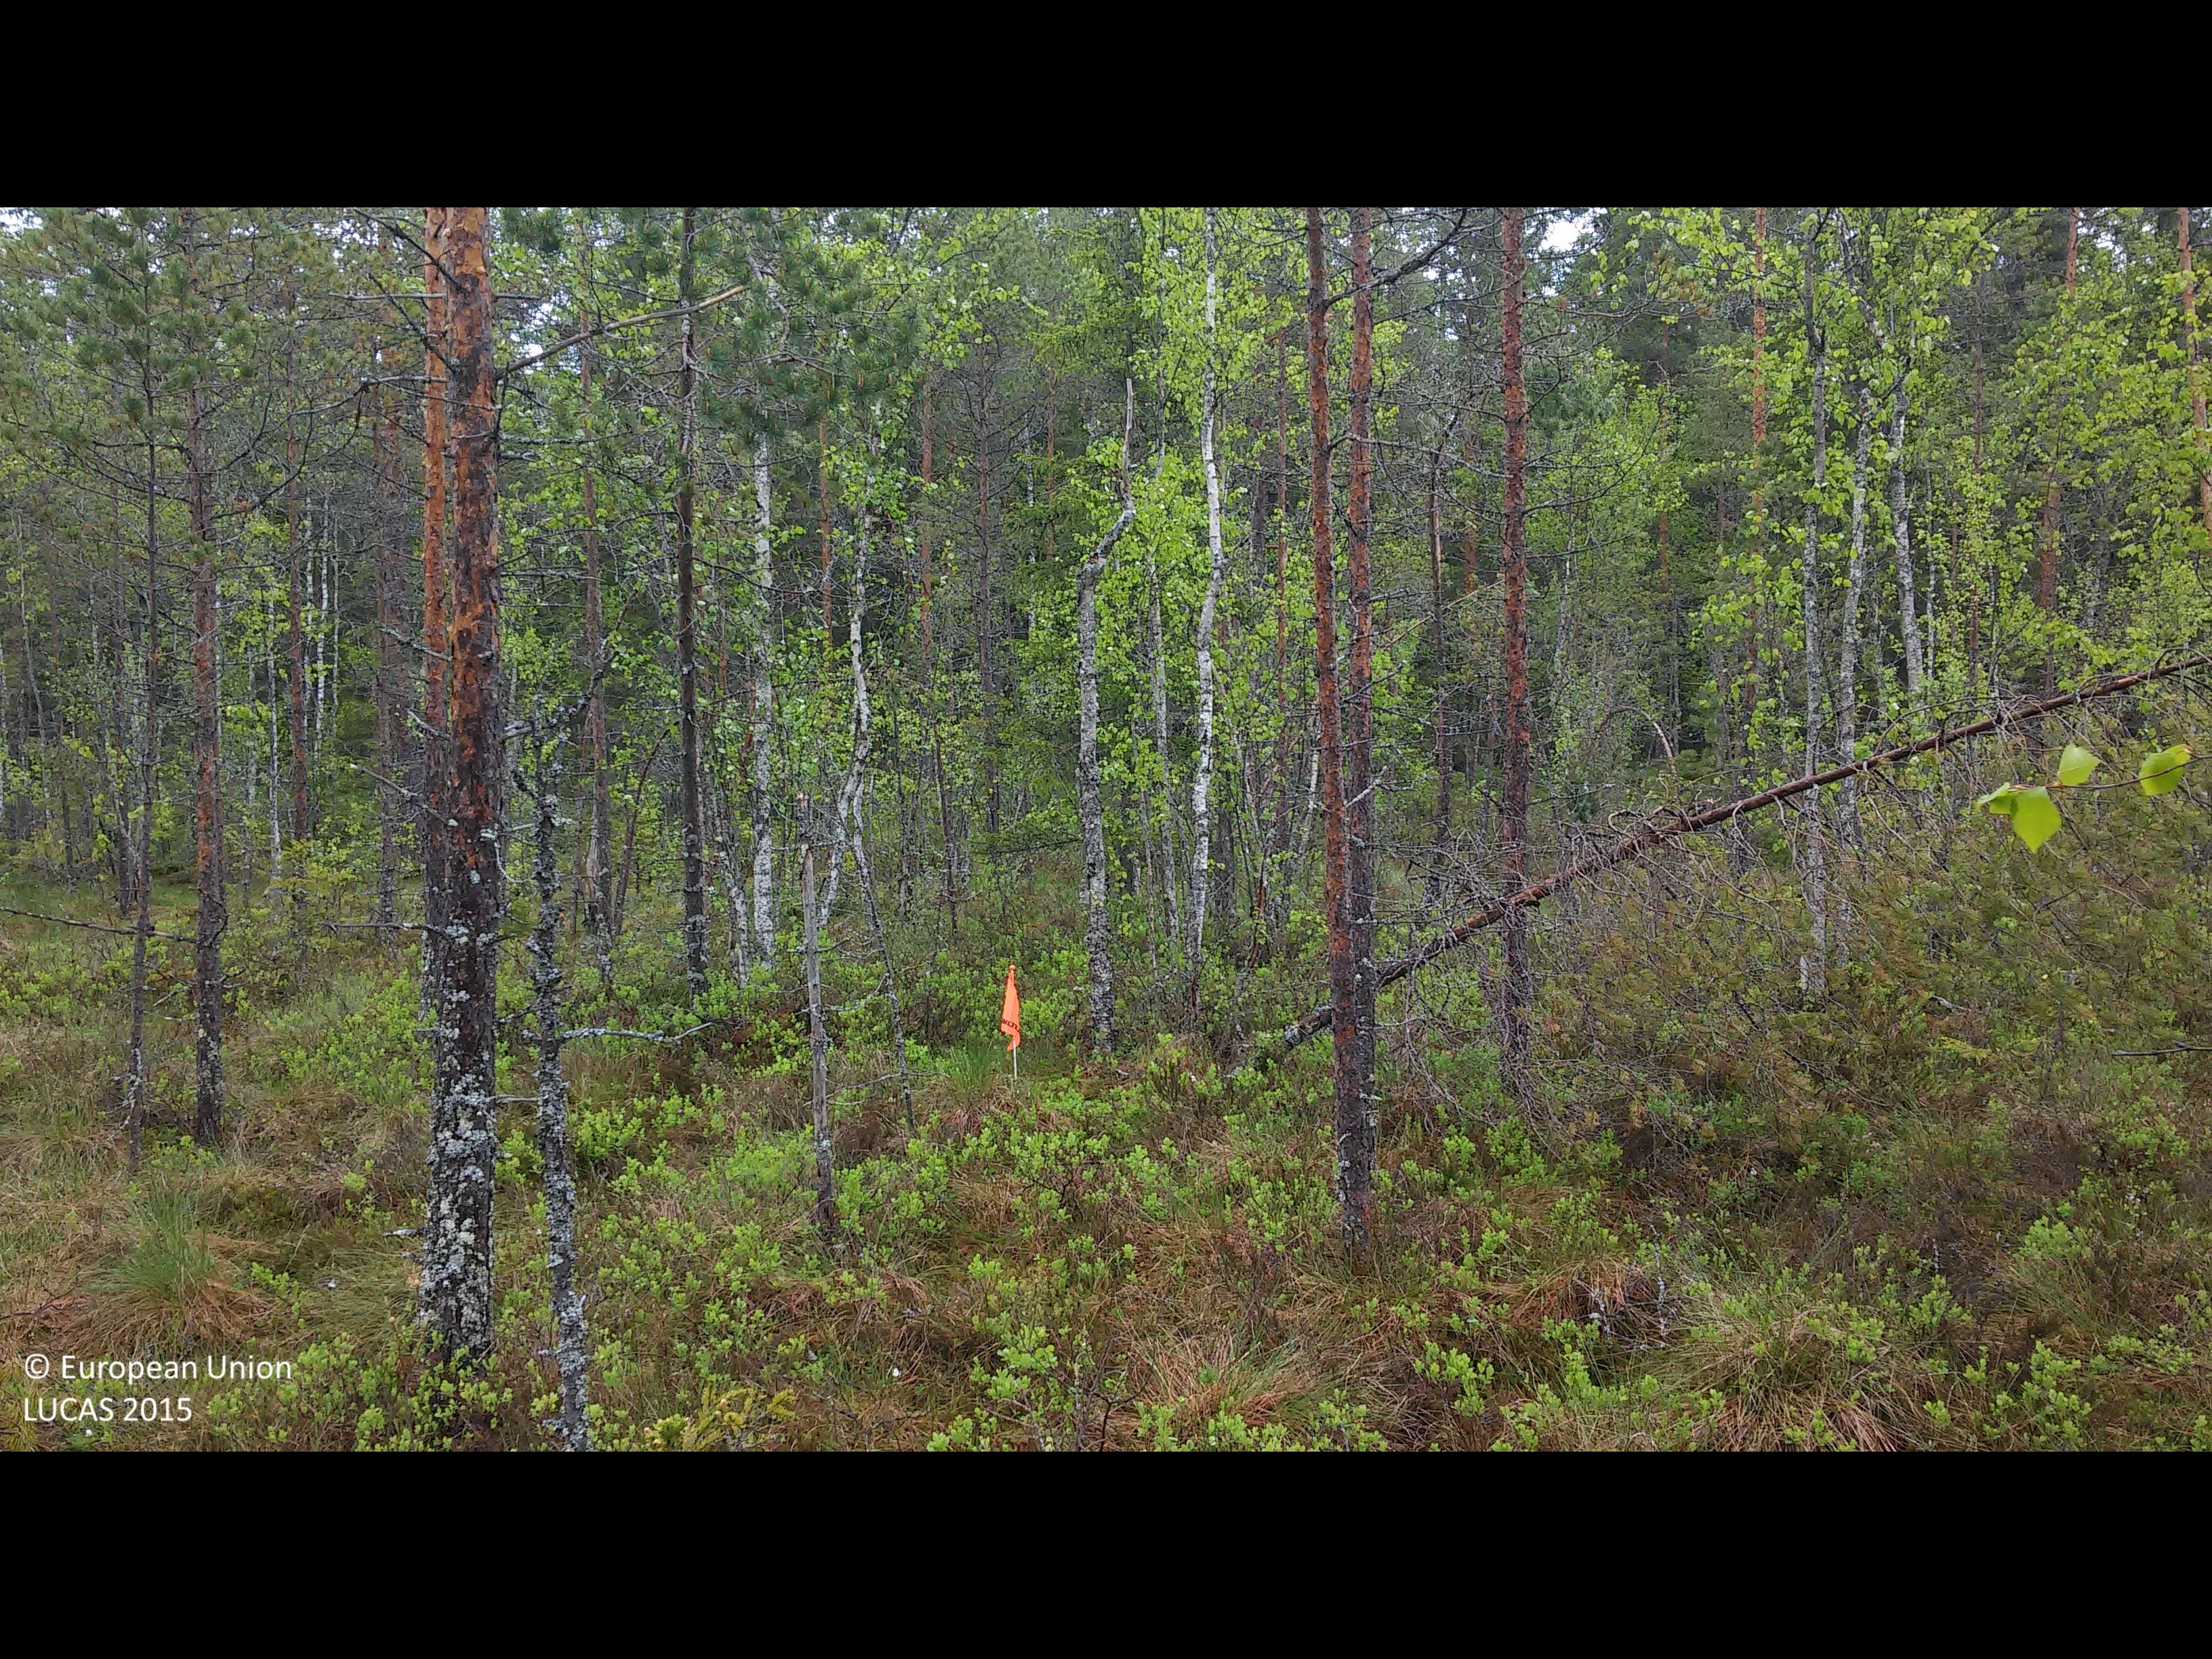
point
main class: Woodland
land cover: Pine dominated mixed woodland
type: boreal forest
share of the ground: > 75 %
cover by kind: coniferous forest trees 55 %, broadleaved forest trees 20 %, shrubs 15 %, lichens and mosses 10 %
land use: Semi-natural and natural areas not in use
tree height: > 5 m
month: June
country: FI
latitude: 63.7030
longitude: 23.9669
